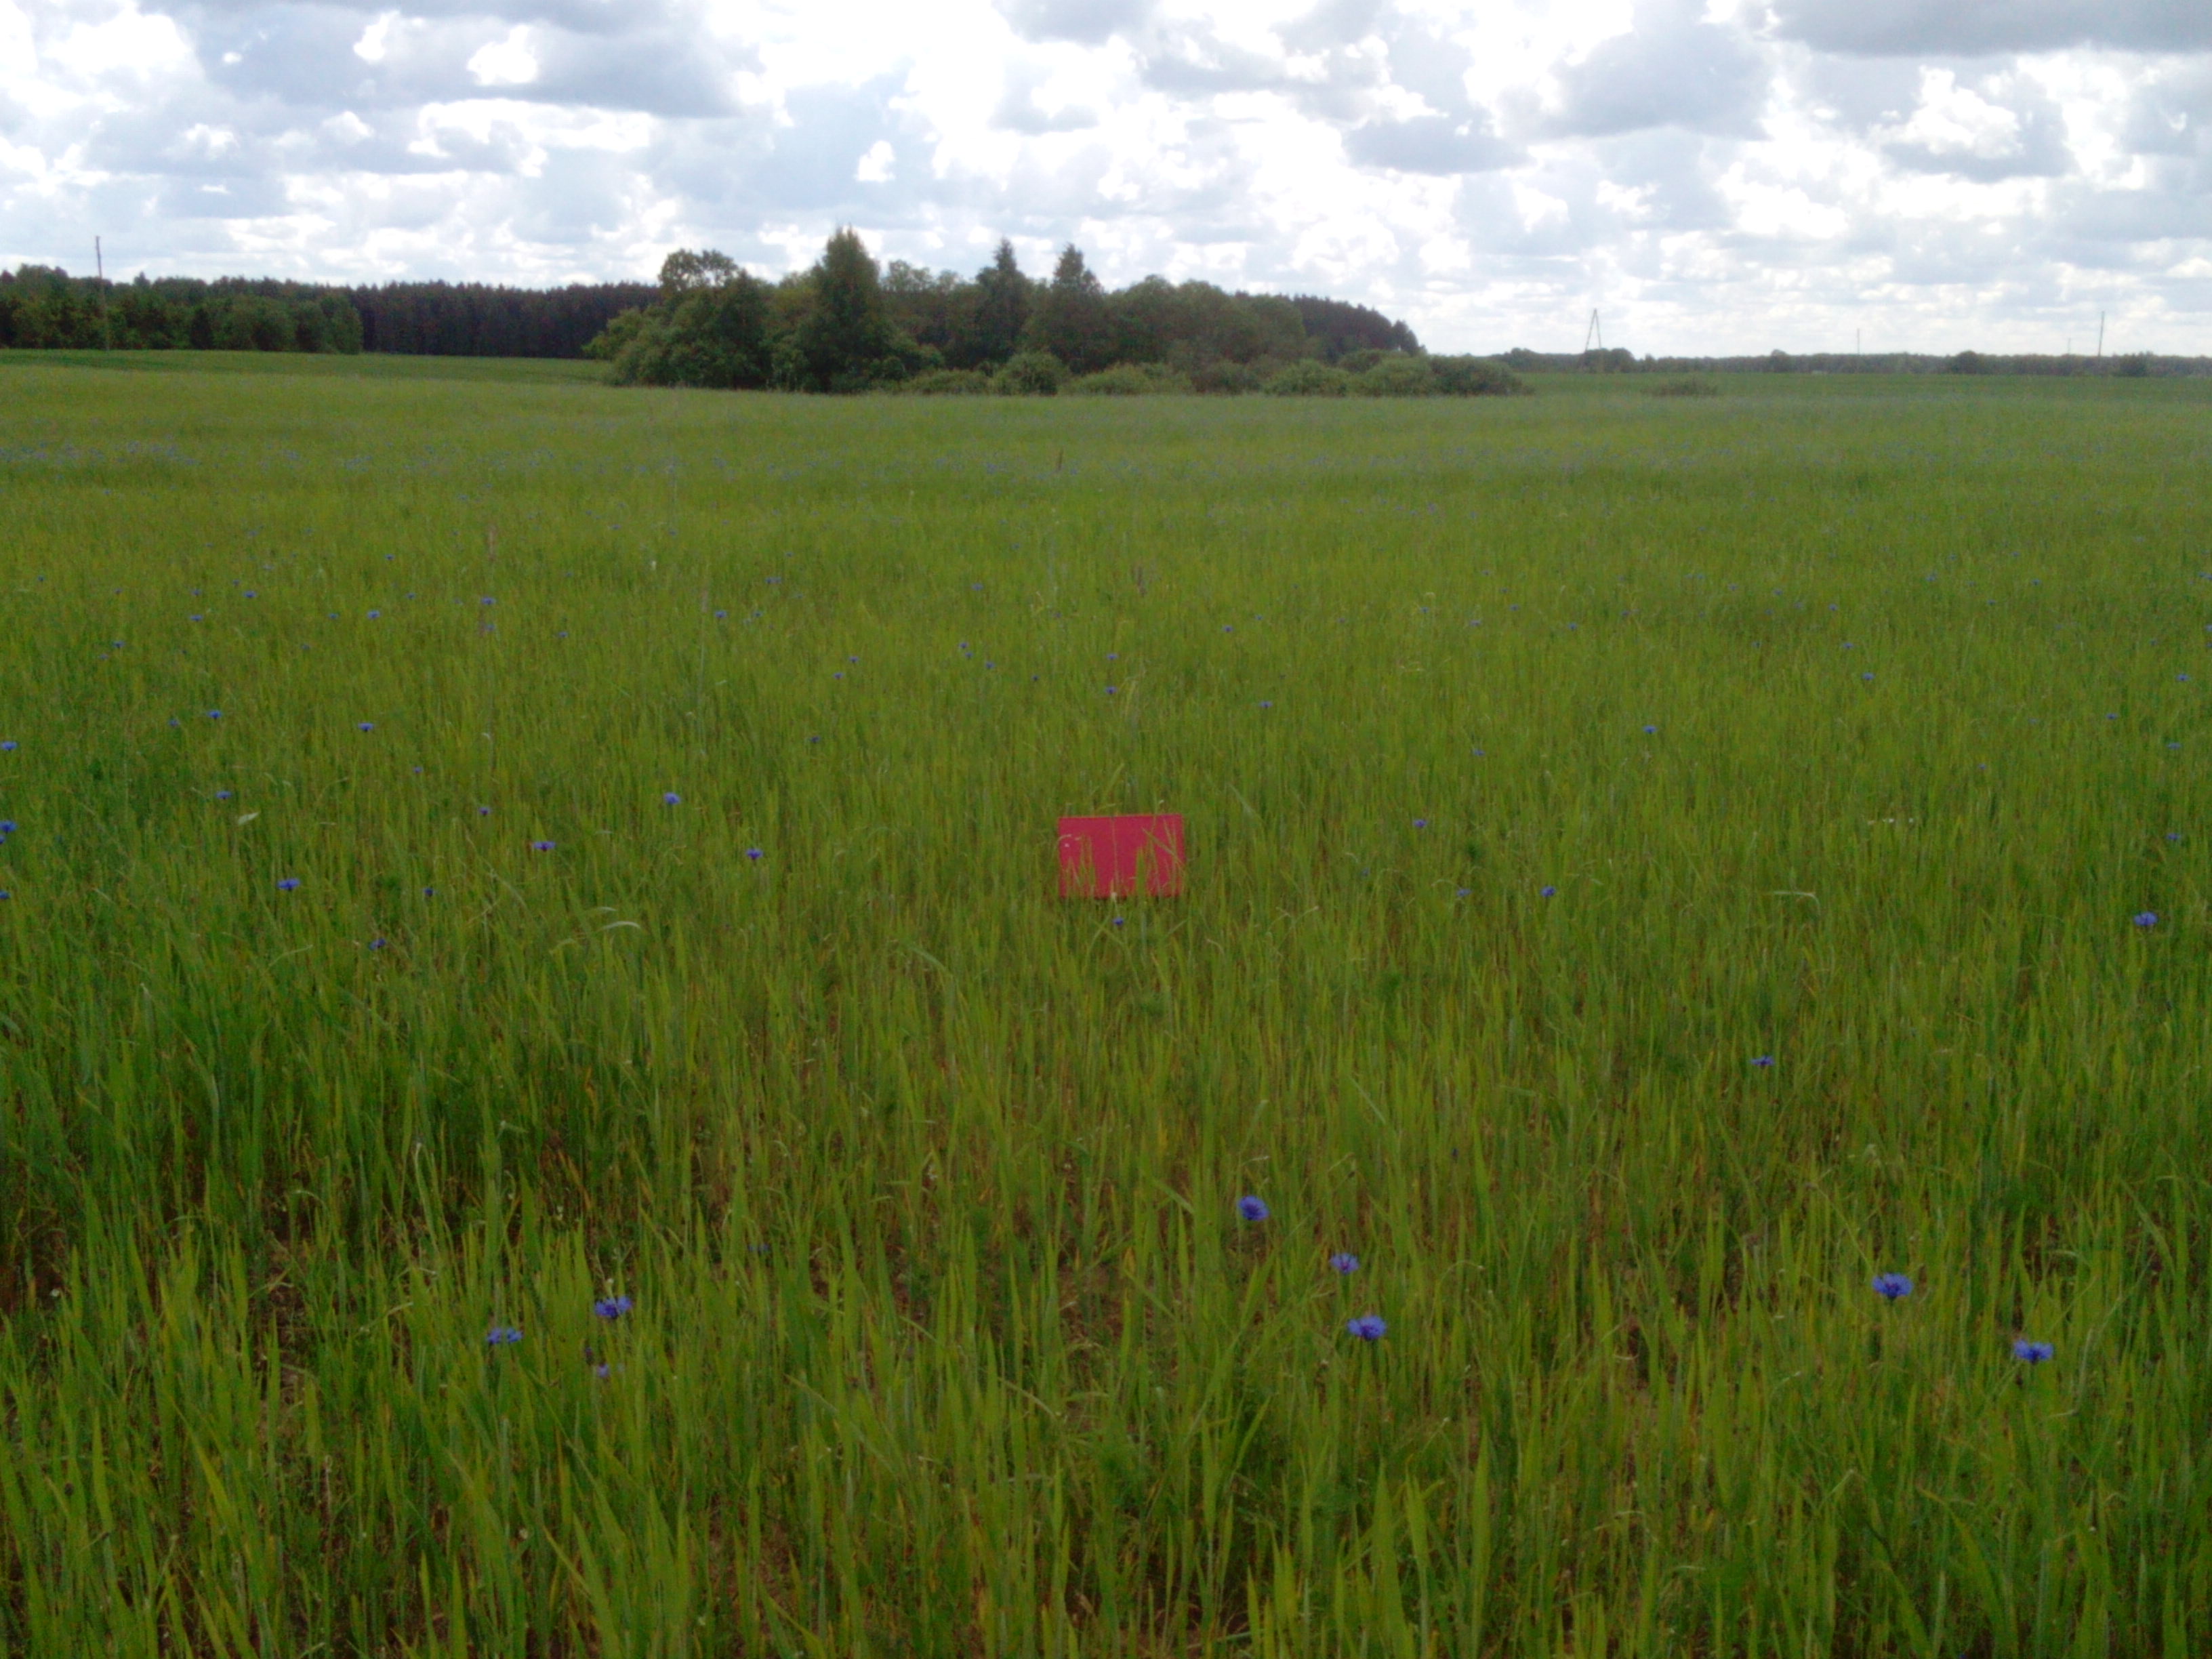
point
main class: Cropland
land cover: Common wheat
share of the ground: > 75 %
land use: Agriculture (excluding fallow land and kitchen gardens)
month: June
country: LV
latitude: 56.7801
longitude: 21.8793
